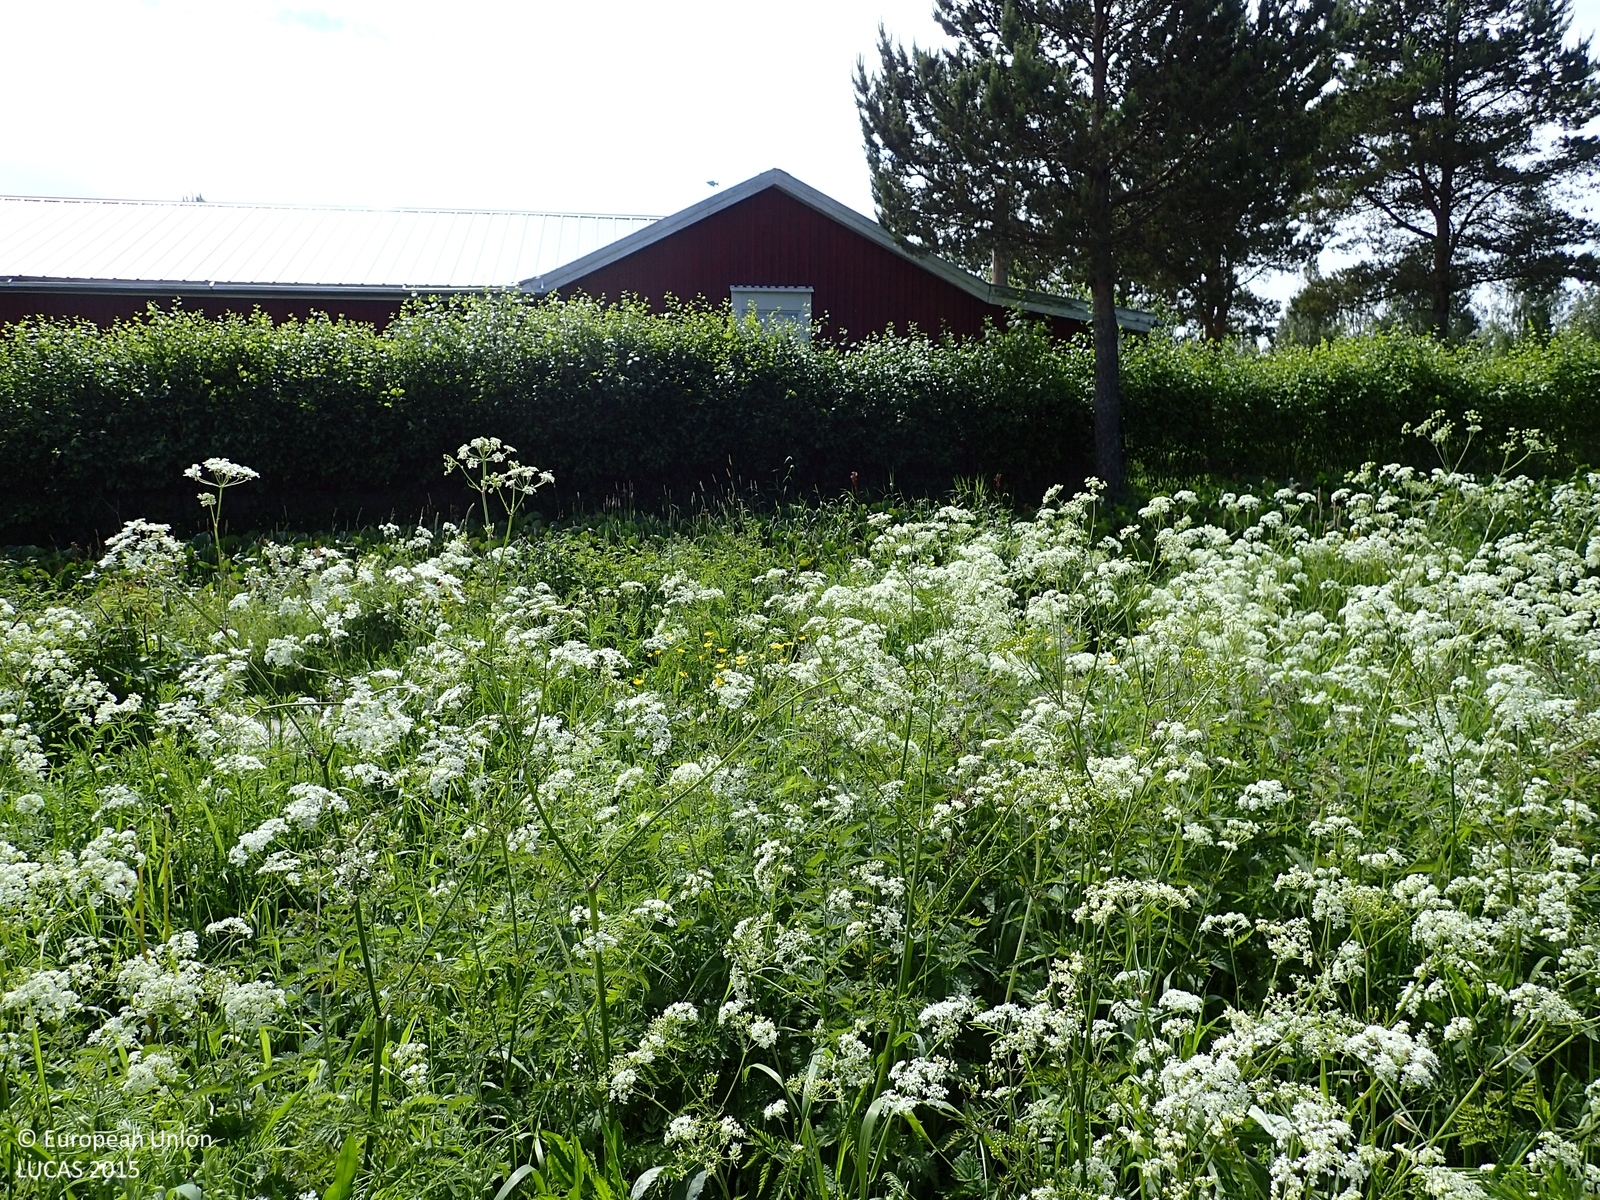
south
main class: Cropland
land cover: Oats
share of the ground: > 75 %
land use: Agriculture (excluding fallow land and kitchen gardens)
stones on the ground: < 10 %
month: June
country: FI
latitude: 62.3854
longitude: 21.5511
